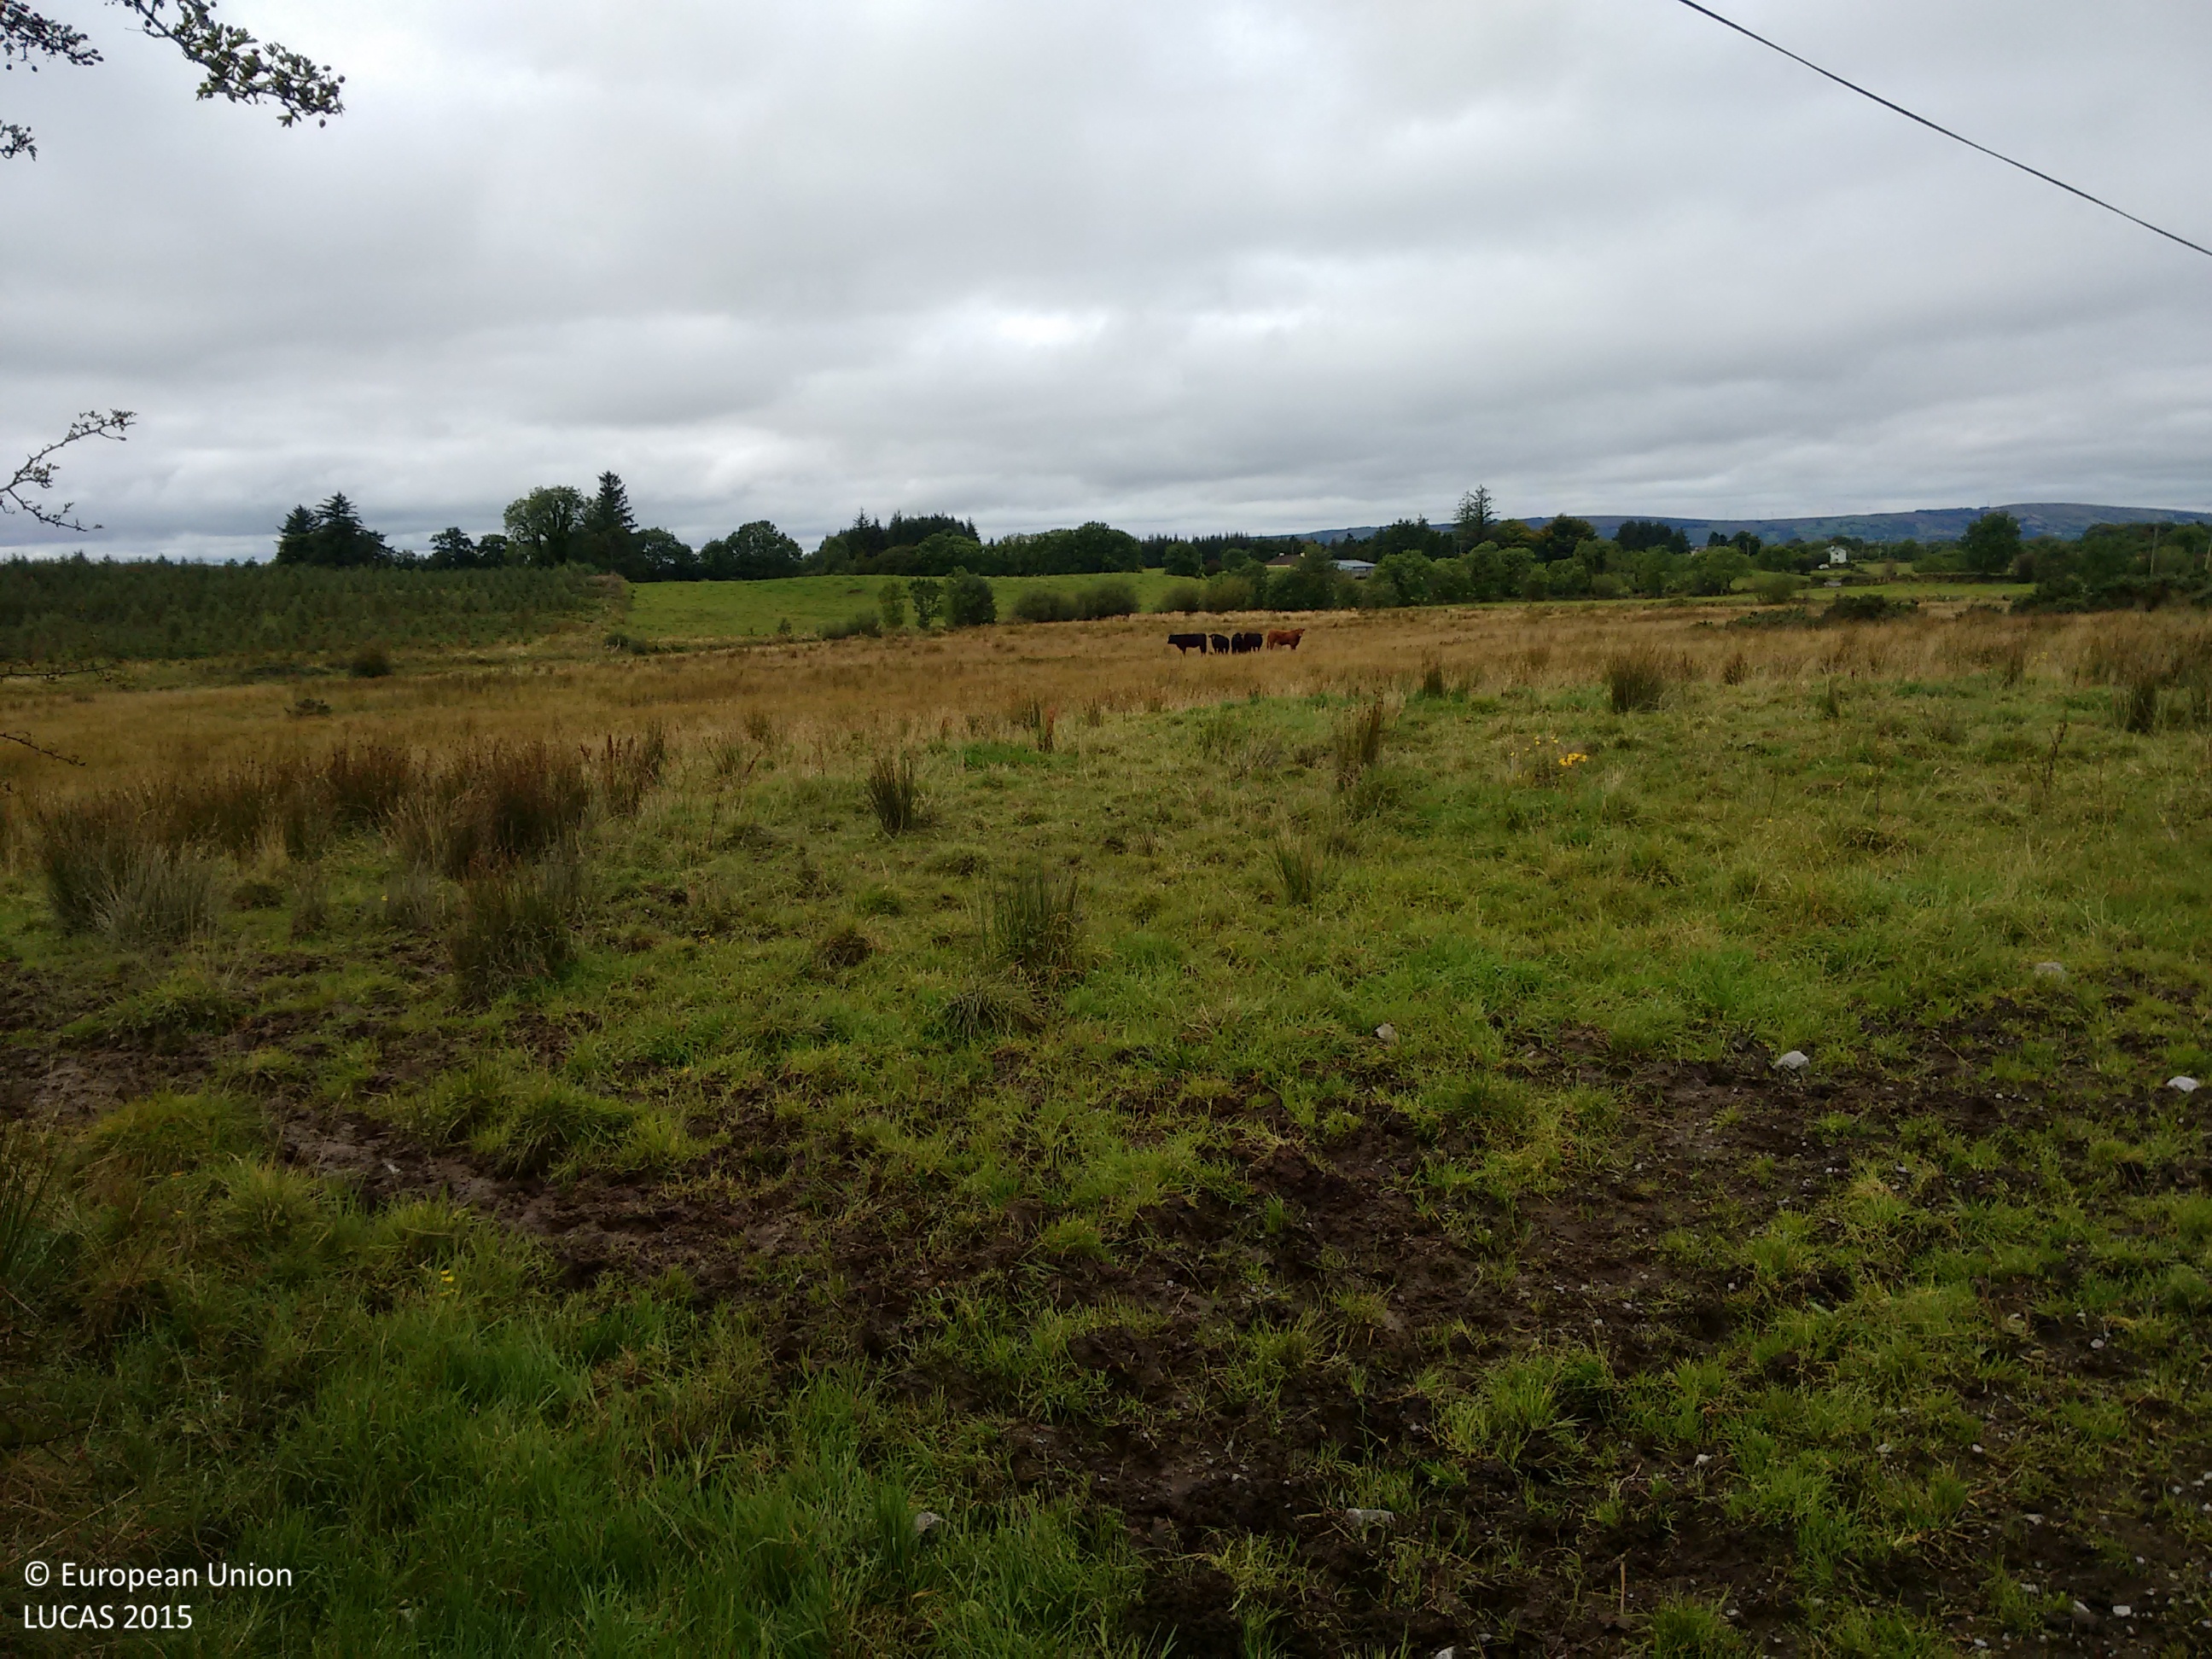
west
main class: Grassland
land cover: Grassland without tree/shrub cover
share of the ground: > 75 %
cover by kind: herbaceous plants 100 %
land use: Agriculture (excluding fallow land and kitchen gardens)
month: September
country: IE
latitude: 53.8120
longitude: -8.9353
